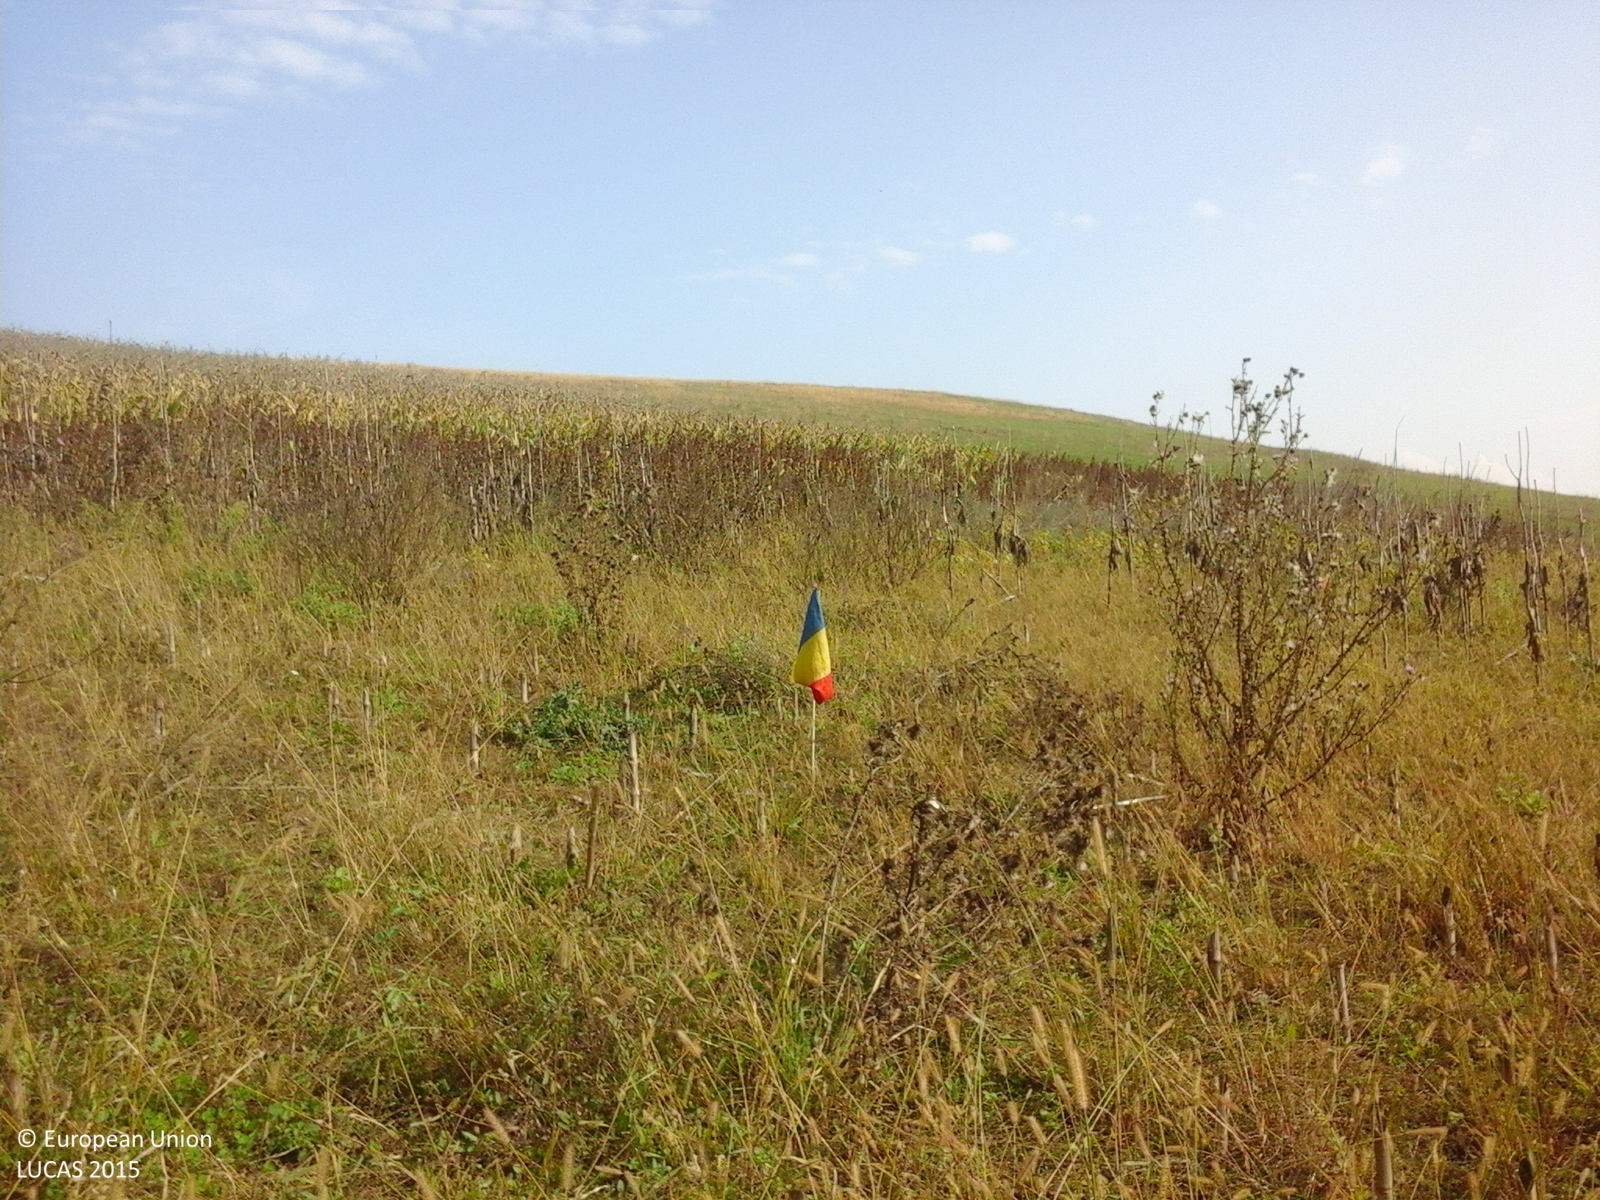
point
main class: Grassland
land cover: Spontaneously vegetated surfaces
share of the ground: > 75 %
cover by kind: herbaceous plants 100 %
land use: Agriculture (excluding fallow land and kitchen gardens)
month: October
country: RO
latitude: 46.6720
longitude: 24.2391
